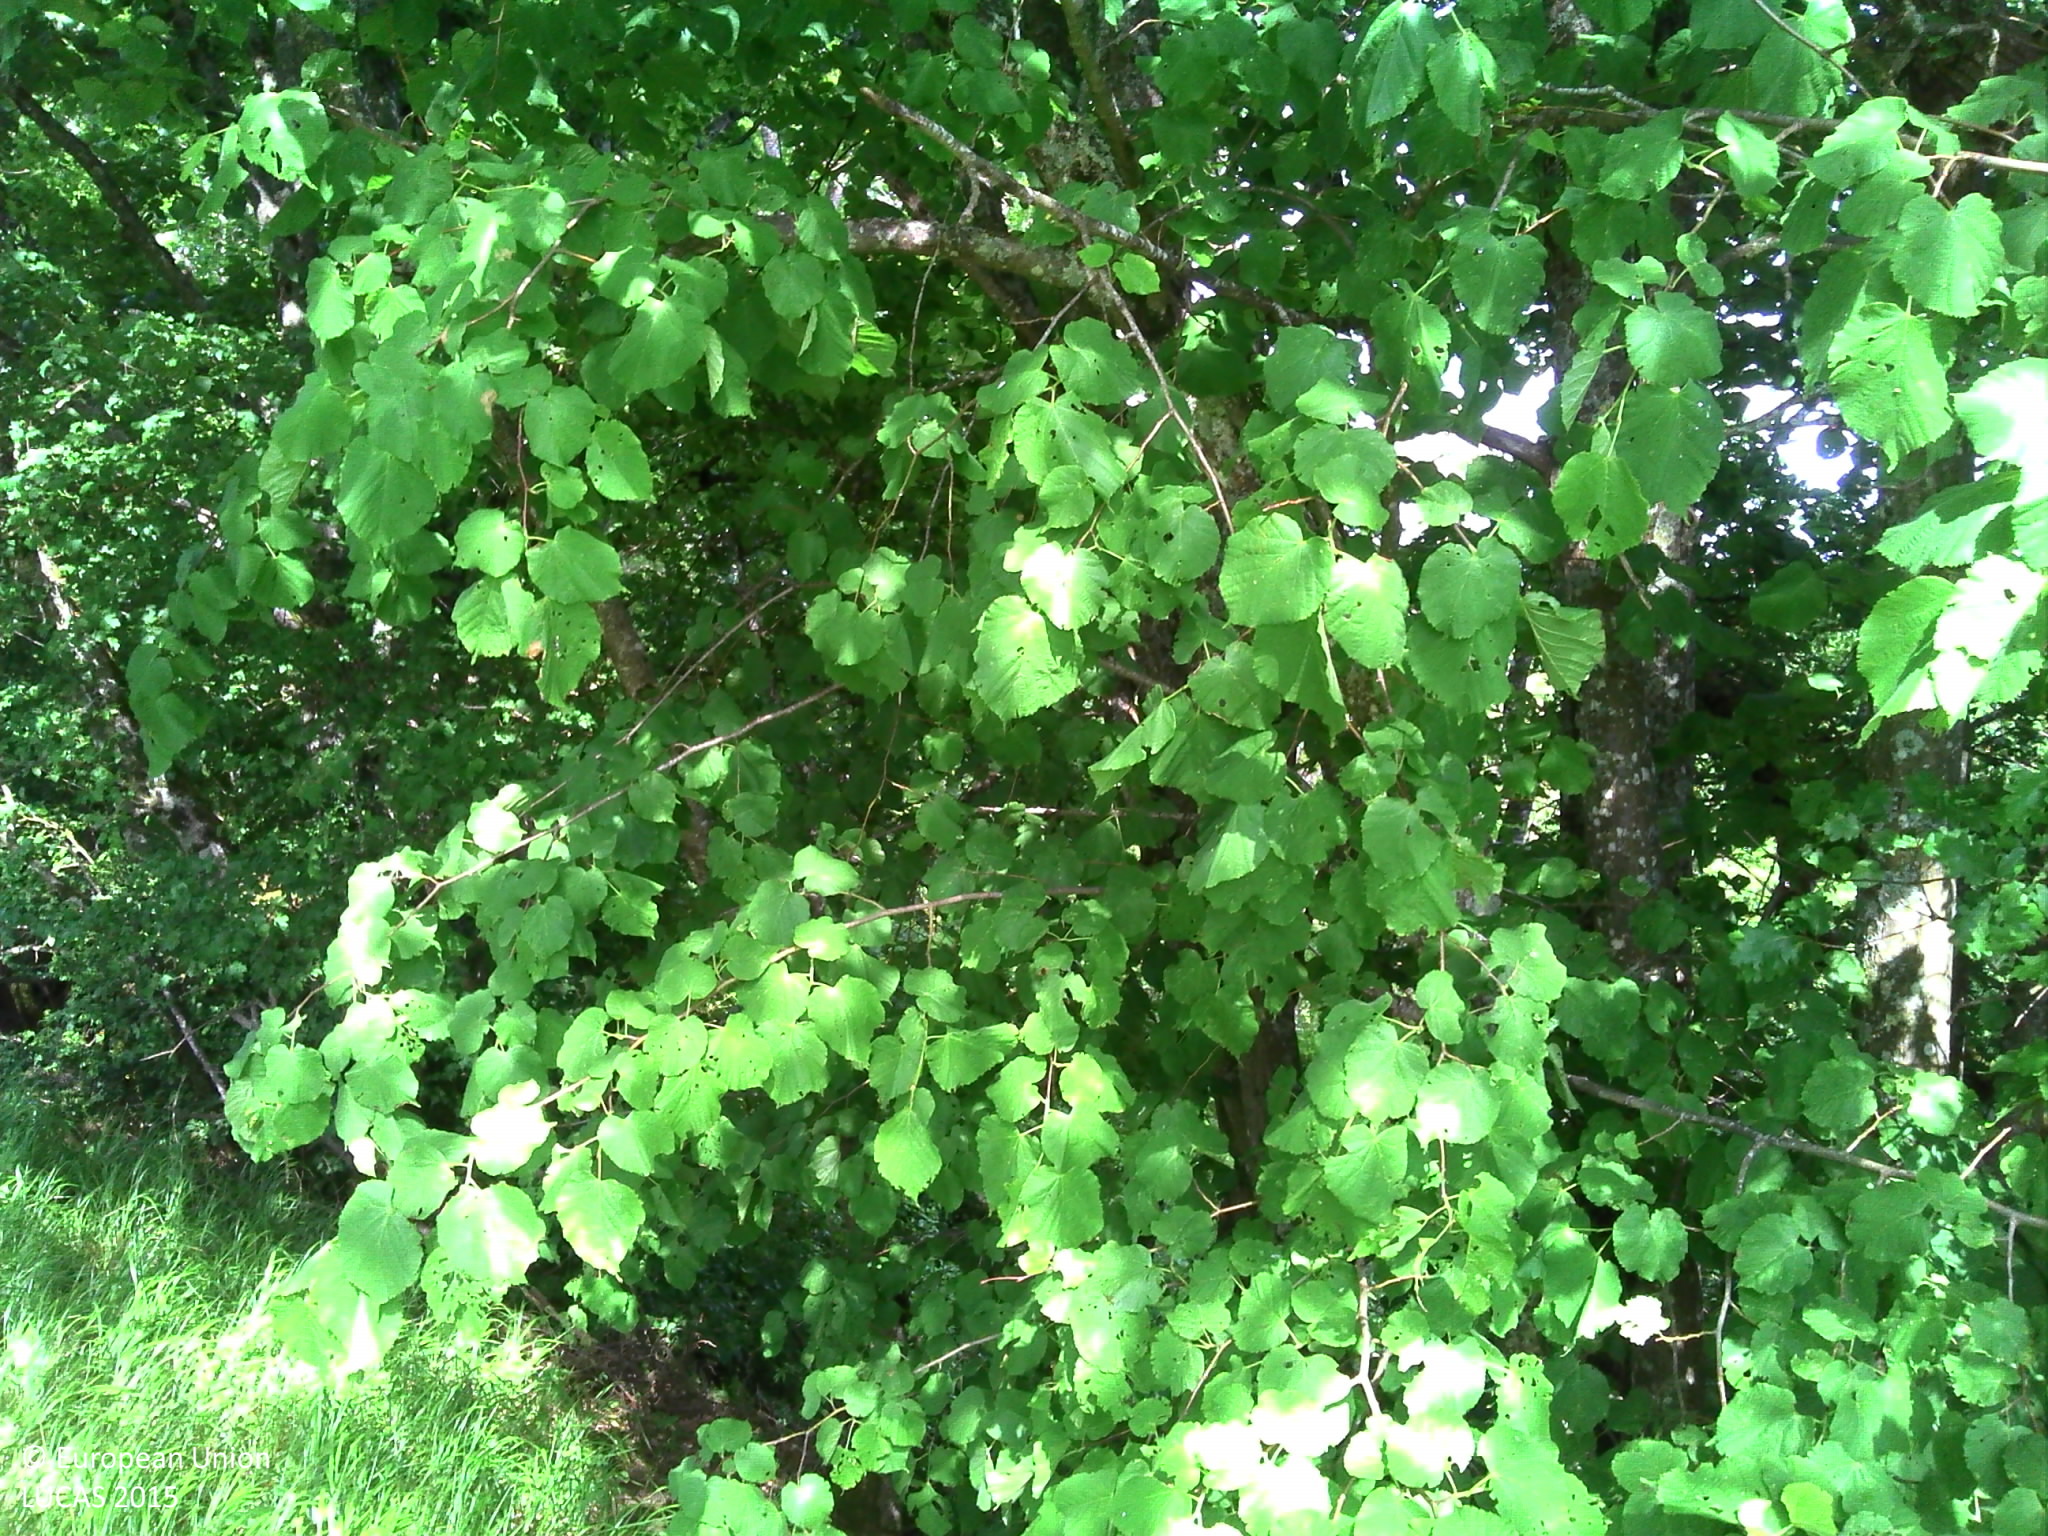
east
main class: Woodland
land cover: Broadleaved woodland
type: mesophytic deciduous forest
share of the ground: > 75 %
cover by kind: broadleaved forest trees 90 %, shrubs 10 %
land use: Forestry
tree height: > 5 m
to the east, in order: Broadleaved woodland; Tracks; Broadleaved woodland
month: May
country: FR
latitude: 47.2969
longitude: 4.9619
